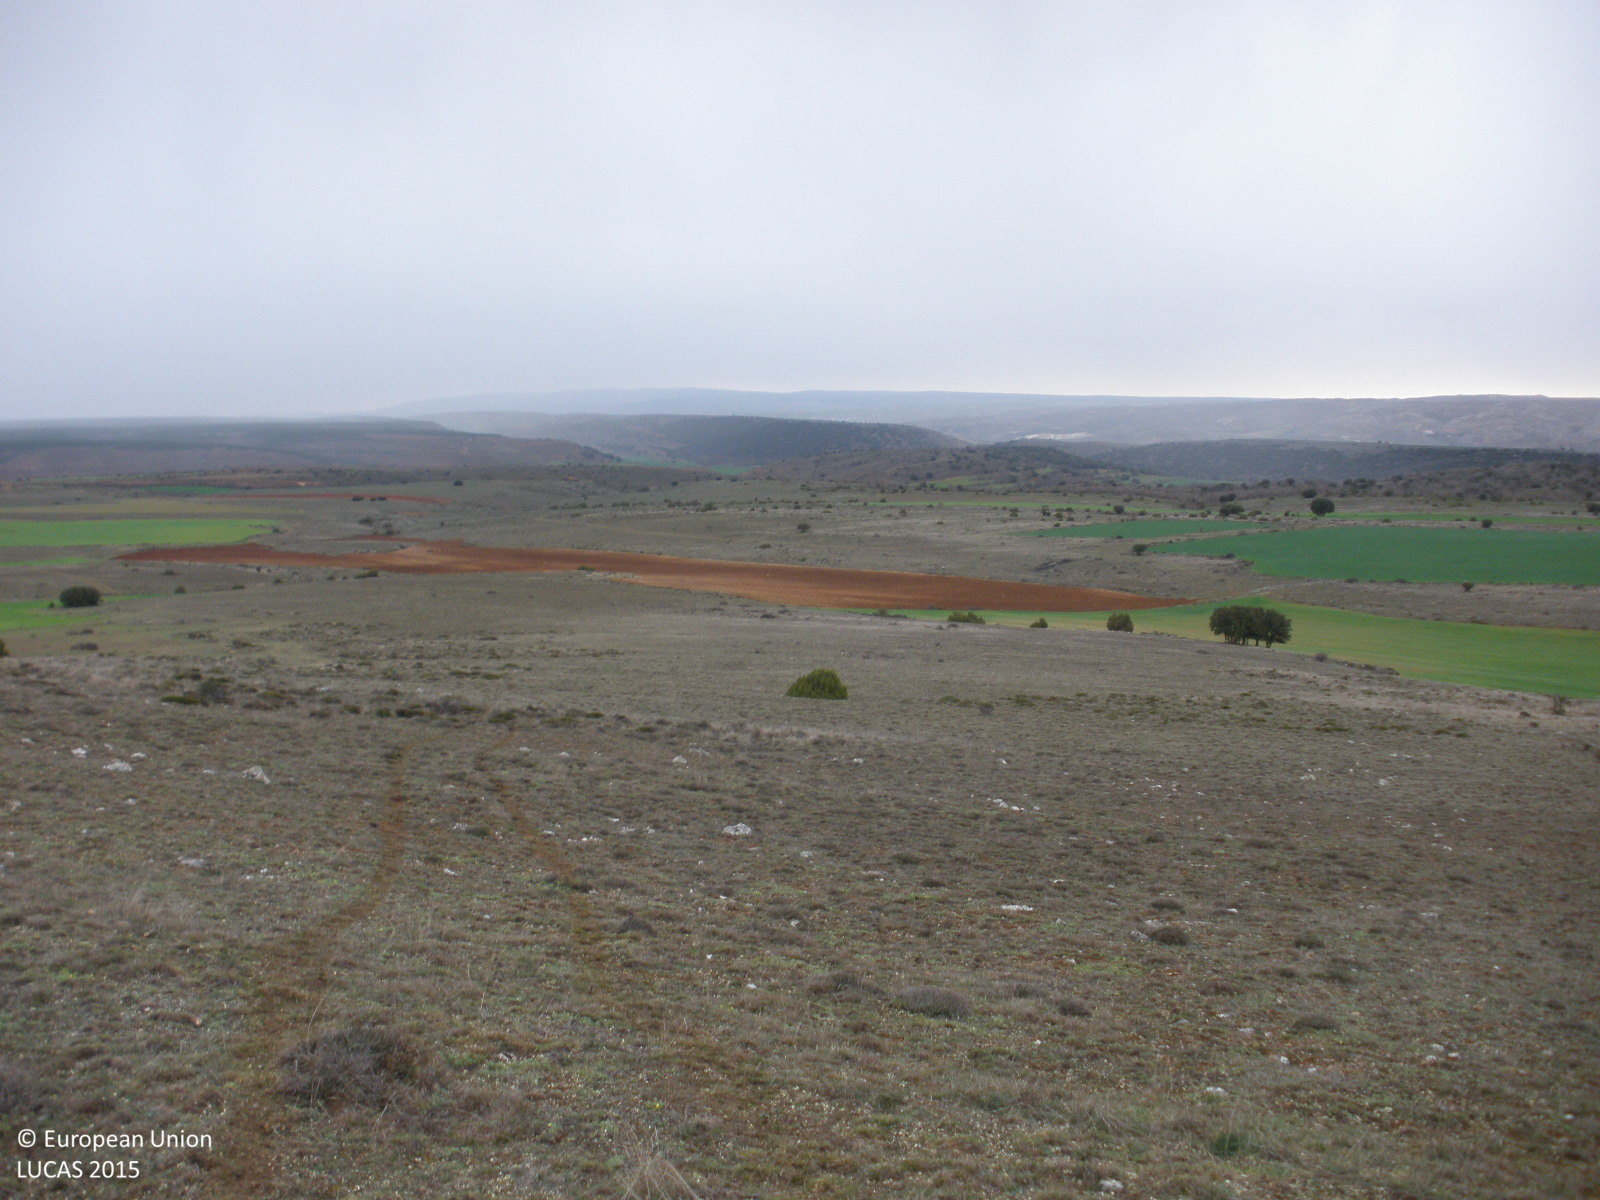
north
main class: Shrubland
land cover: Shrubland without tree cover
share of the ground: 25 - 50 %
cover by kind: herbaceous plants 50 %, shrubs 30 %, consolidated bare surface 20 %
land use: Semi-natural and natural areas not in use
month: April
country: ES
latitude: 40.7494
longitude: -1.0886
